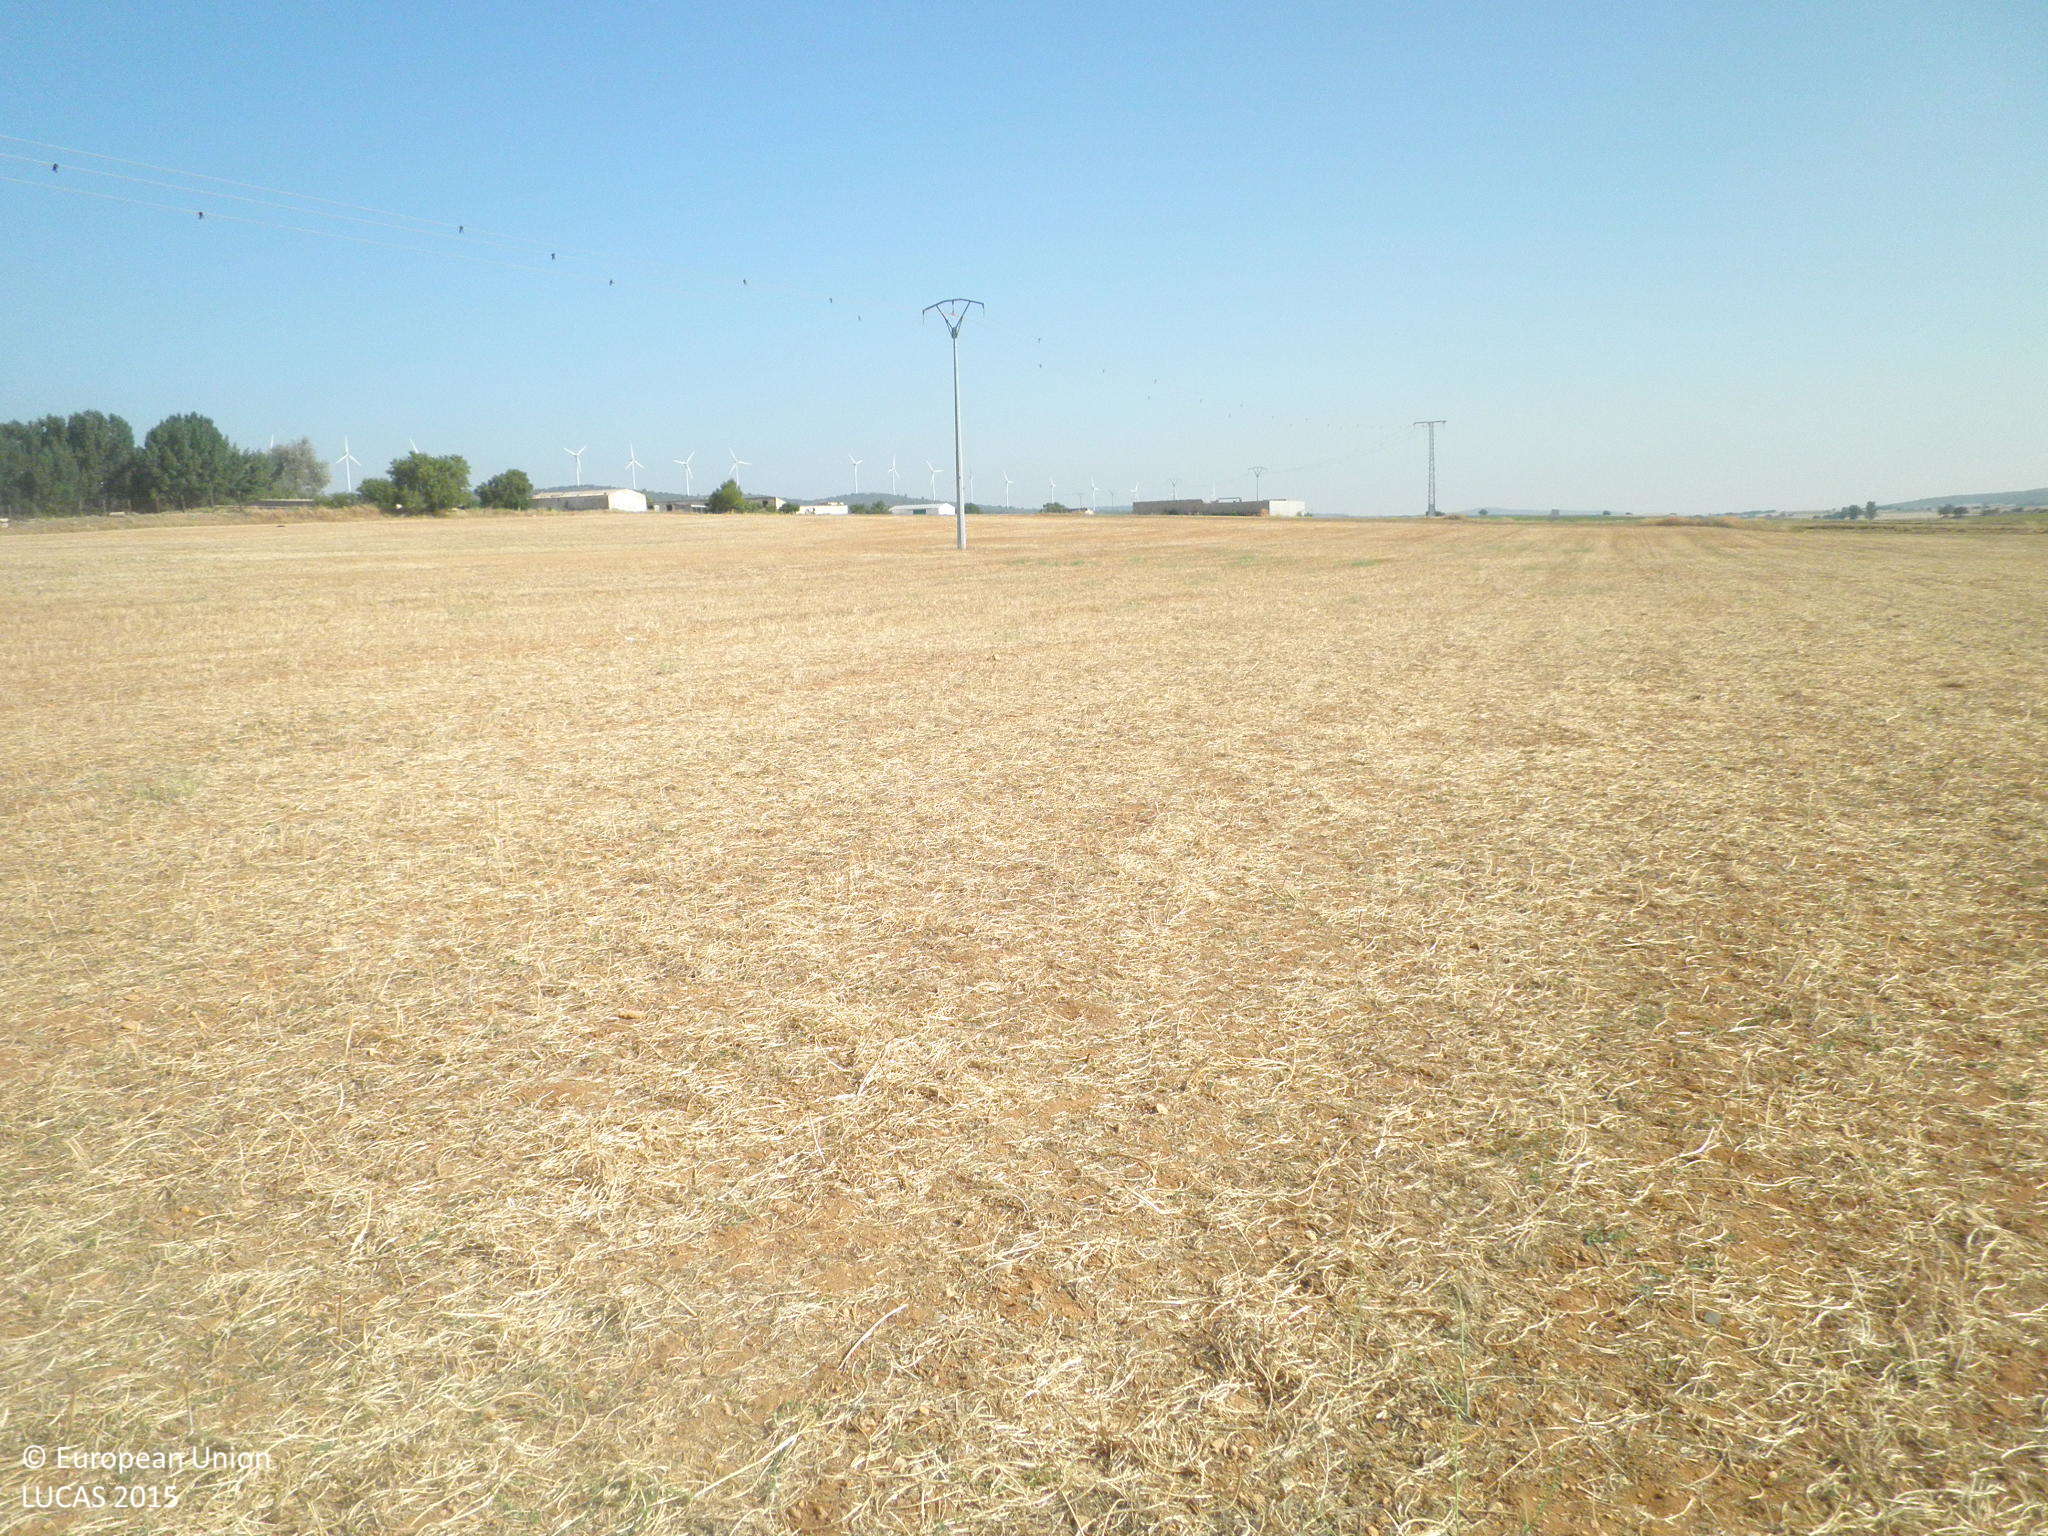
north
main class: Cropland
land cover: Dry pulses
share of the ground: < 10 %
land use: Agriculture (excluding fallow land and kitchen gardens)
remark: Harvested field
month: July
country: ES
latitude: 39.6095
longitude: -1.7827
